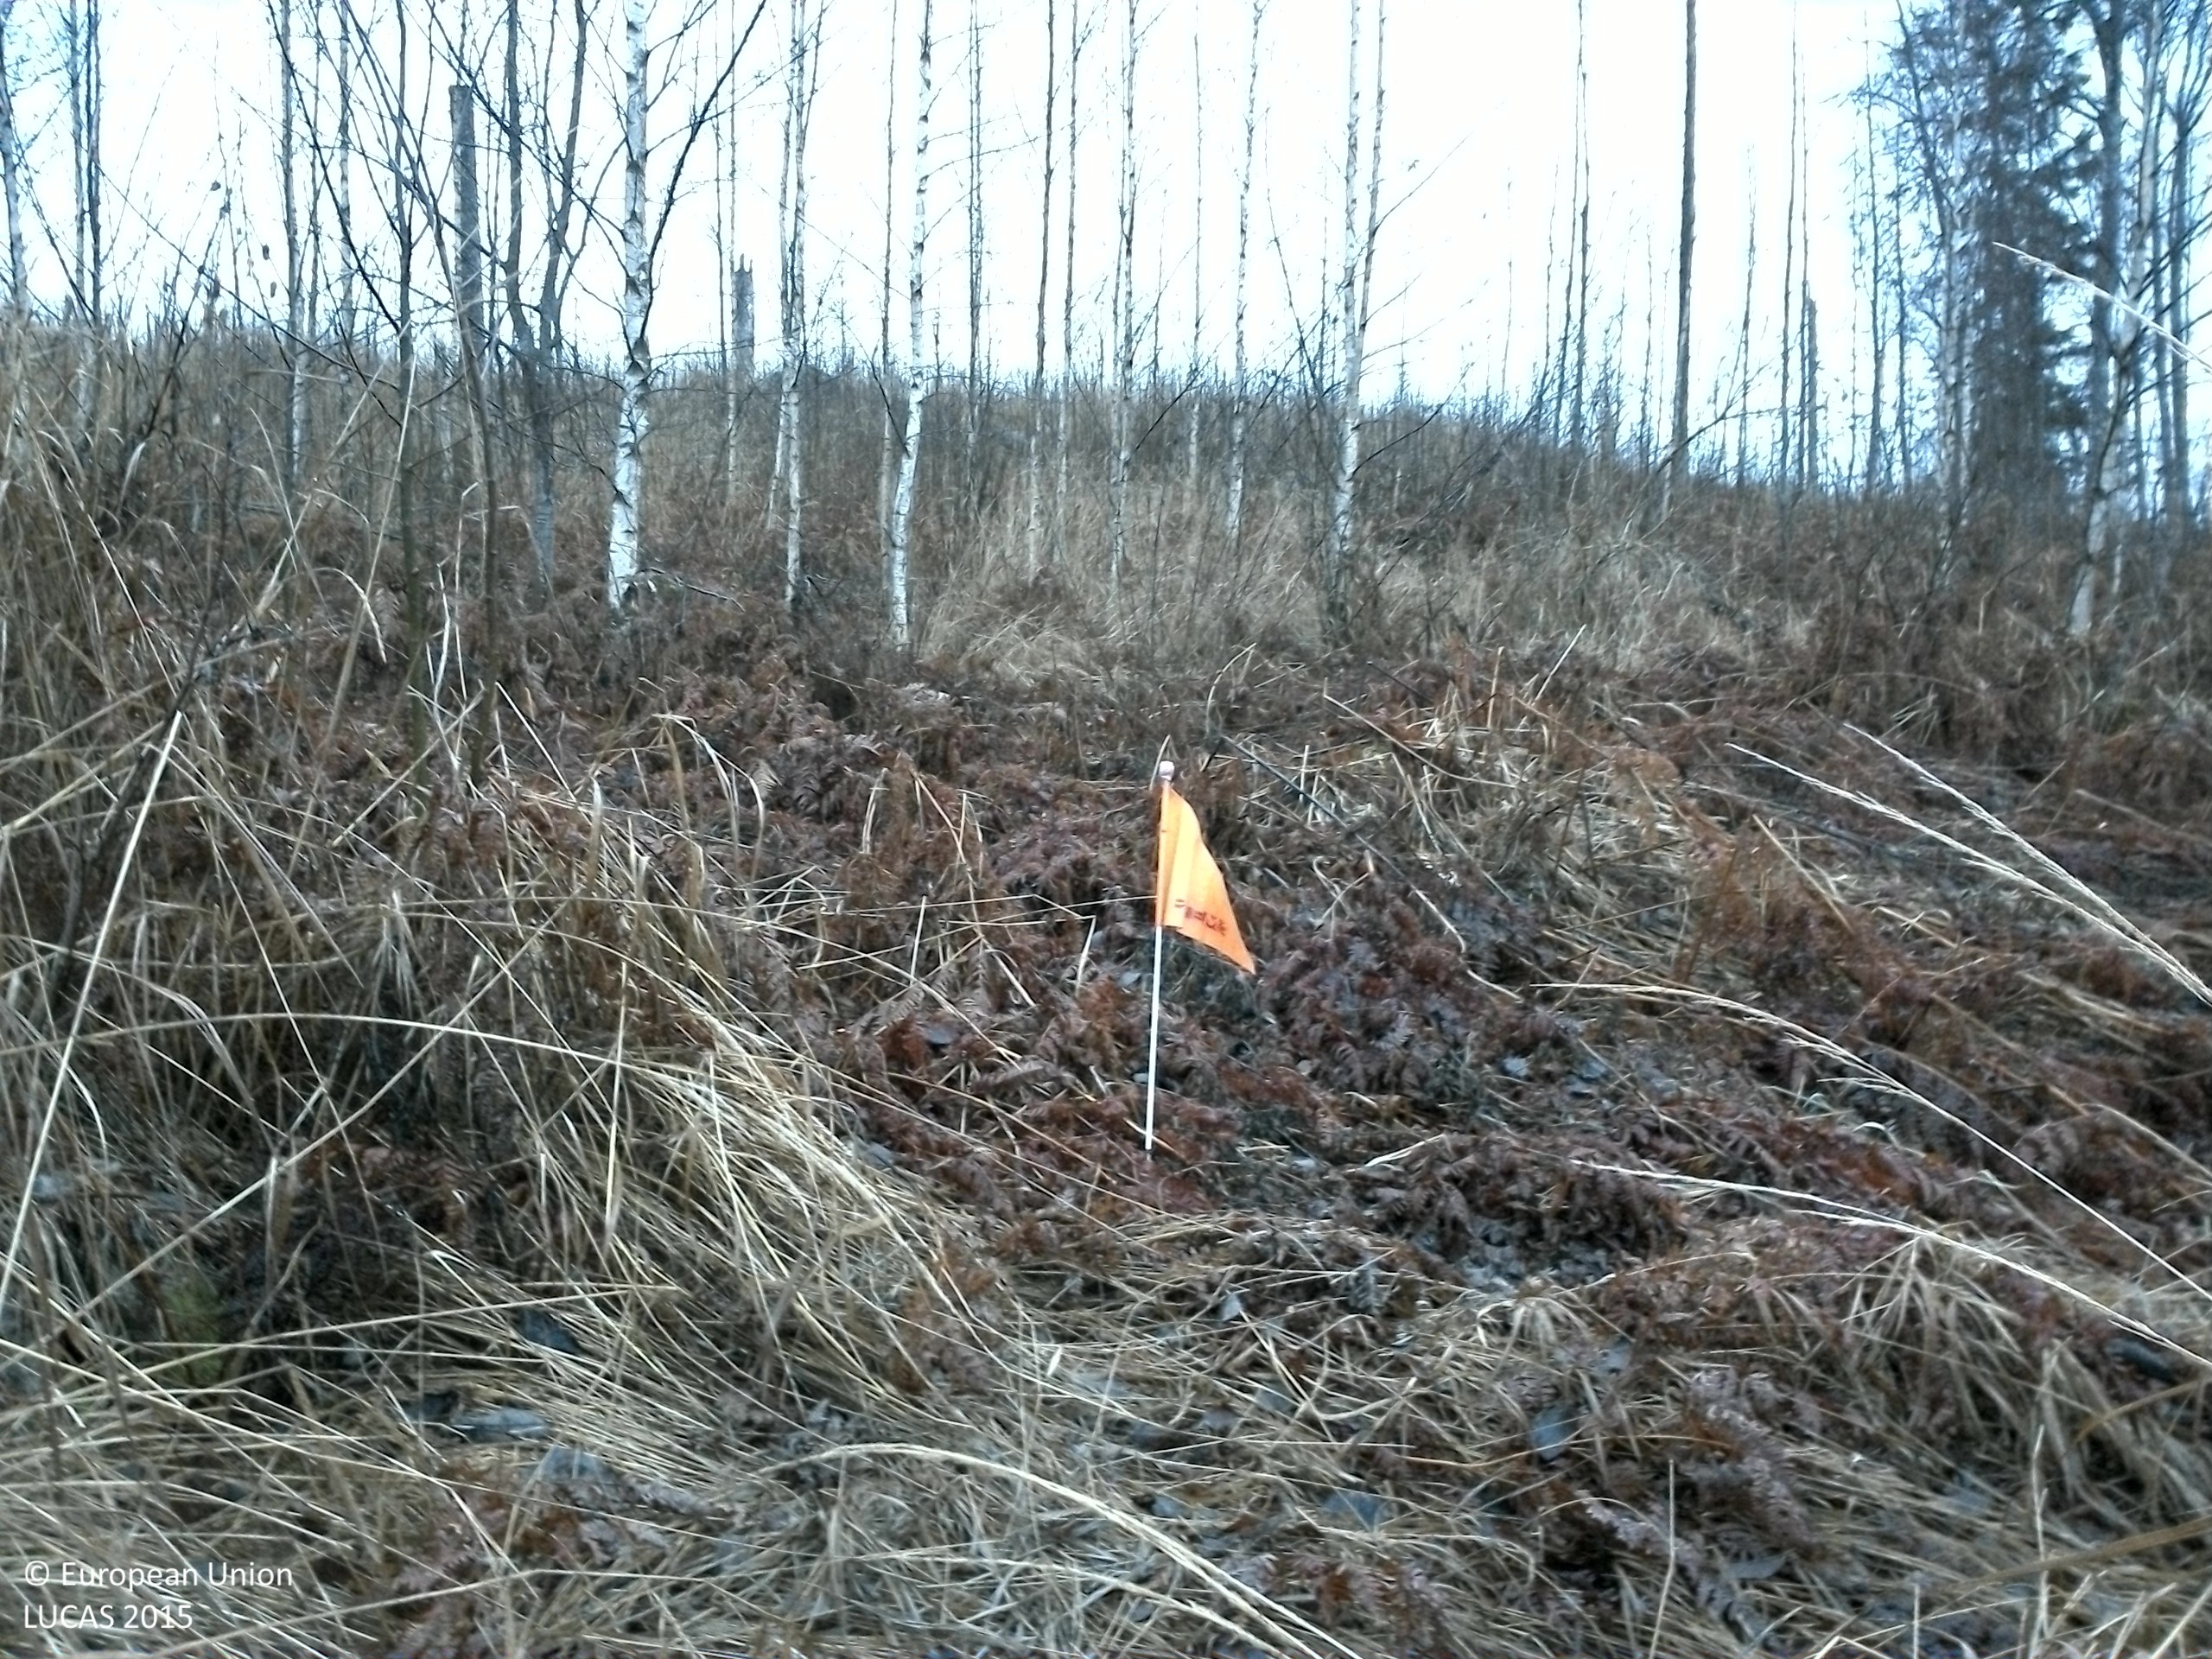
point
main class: Woodland
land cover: Broadleaved woodland
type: hemiboreal forest and nemoral coniferous forest and mixed broadleaved-coniferous forest
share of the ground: 25 - 50 %
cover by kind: herbaceous plants 55 %, broadleaved forest trees 35 %, consolidated bare surface 10 %
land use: Forestry
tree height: > 5 m
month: November
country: SE
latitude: 59.1366
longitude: 16.6879
